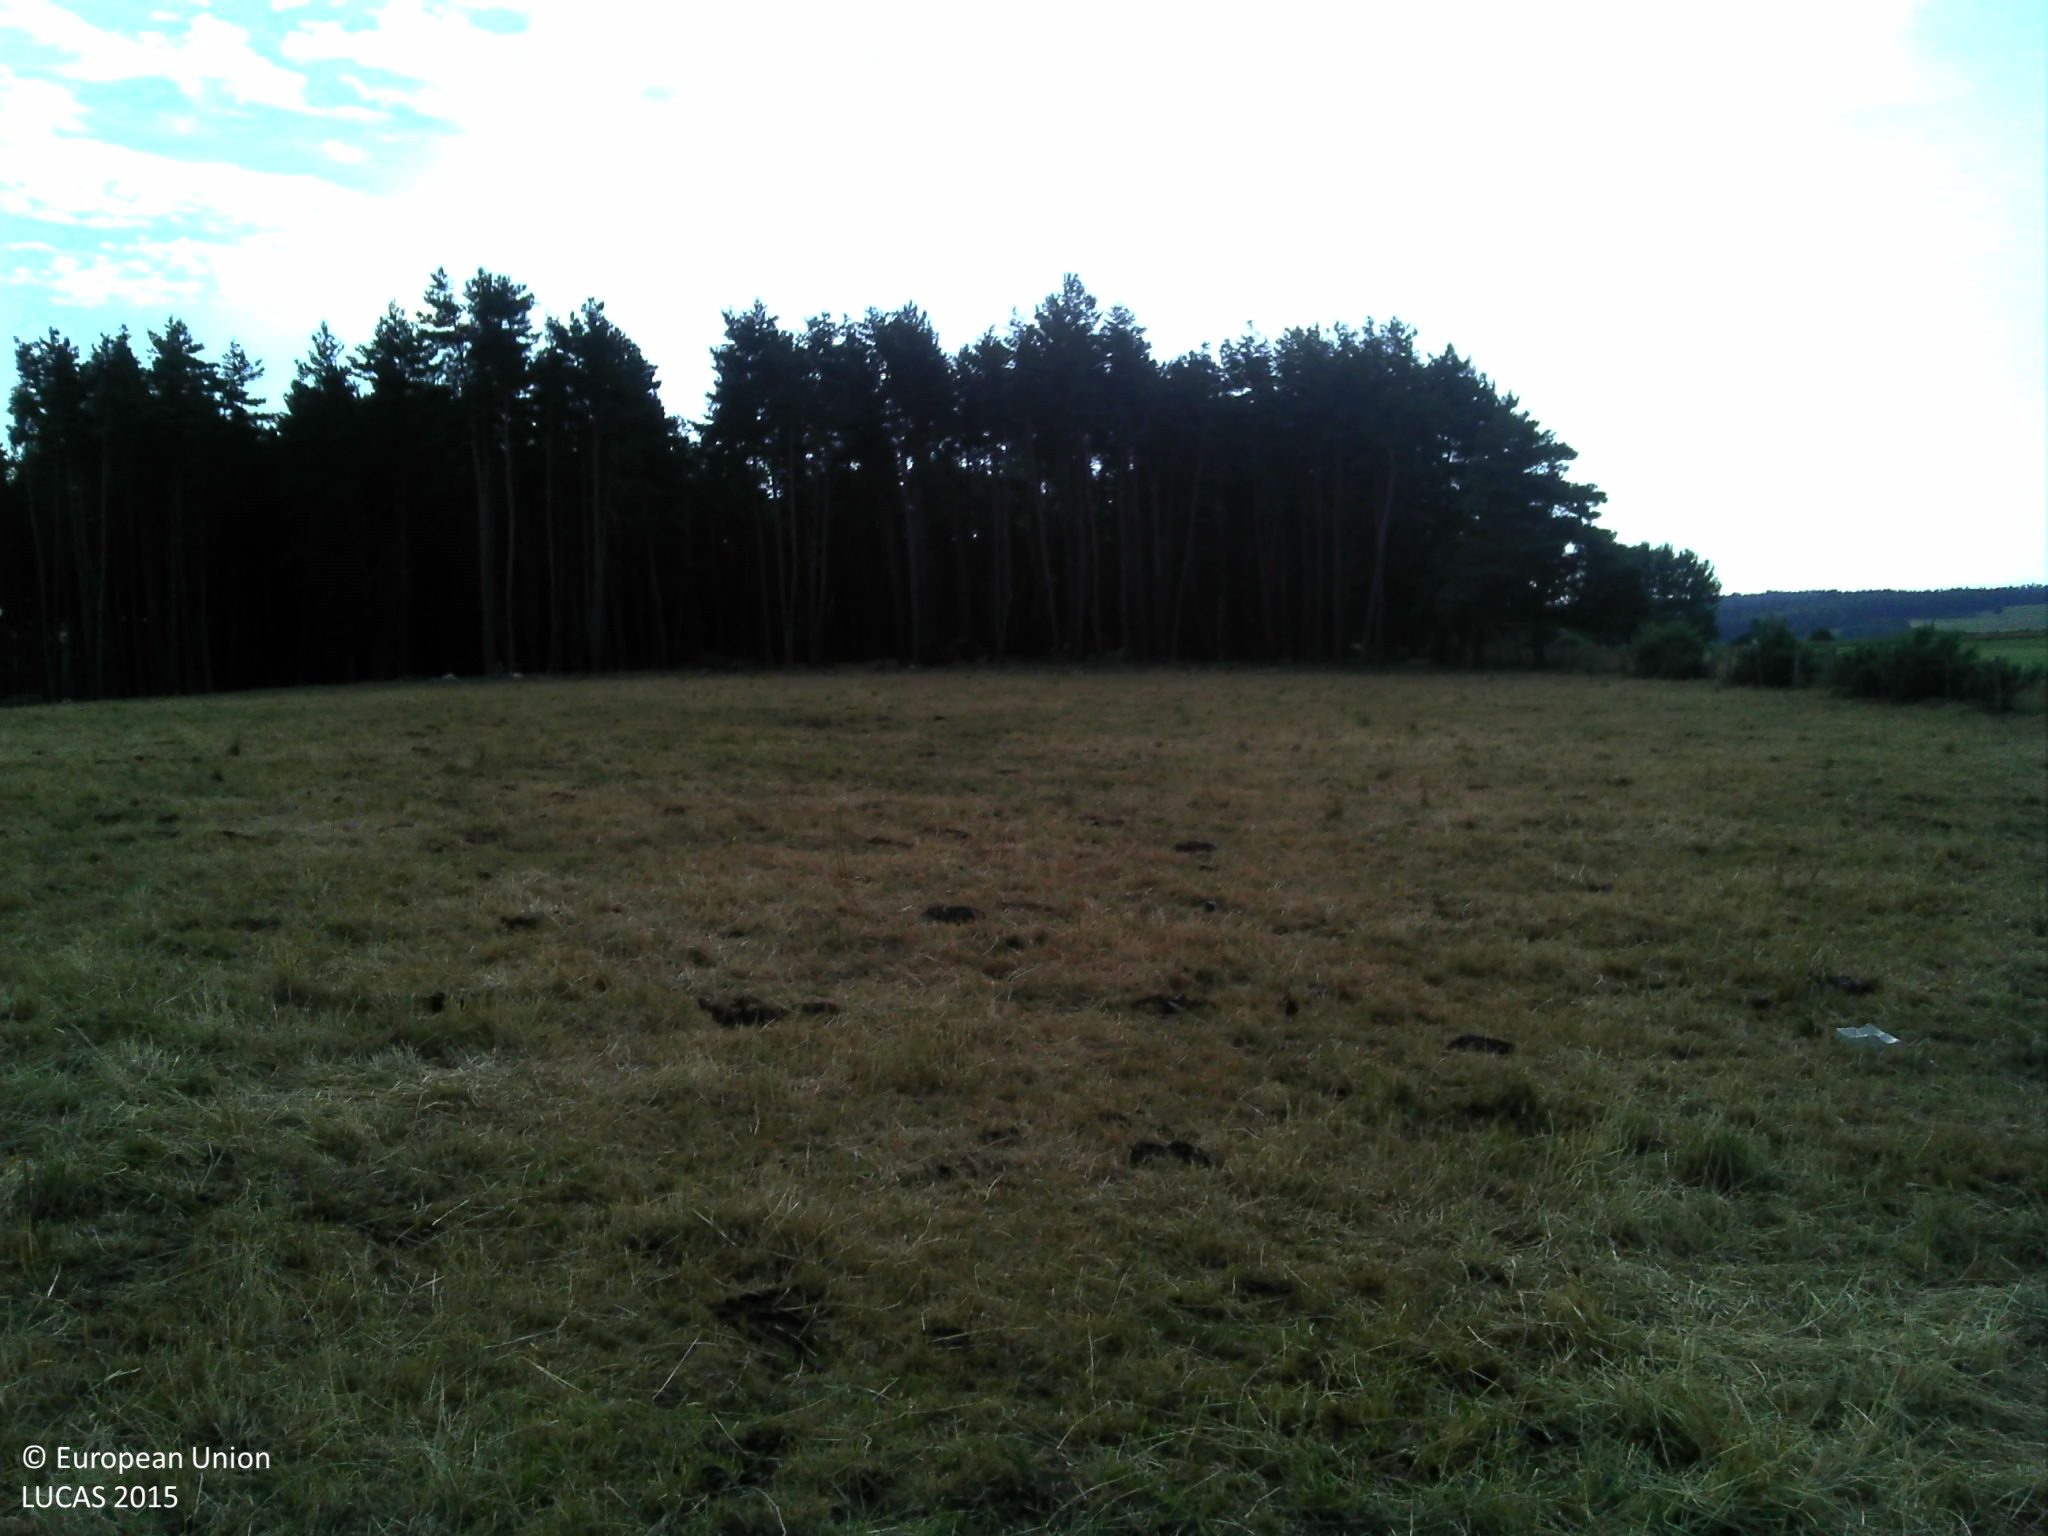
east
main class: Grassland
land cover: Grassland without tree/shrub cover
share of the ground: > 75 %
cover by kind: herbaceous plants 100 %
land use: Agriculture (excluding fallow land and kitchen gardens)
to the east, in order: Grassland without tree/shrub cover; Pine dominated coniferous woodland; Grassland with sparse tree/shrub cover; Pine dominated coniferous woodland; Grassland with sparse tree/shrub cover; Pine dominated coniferous woodland
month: July
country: FR
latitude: 44.8170
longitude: 2.9591
